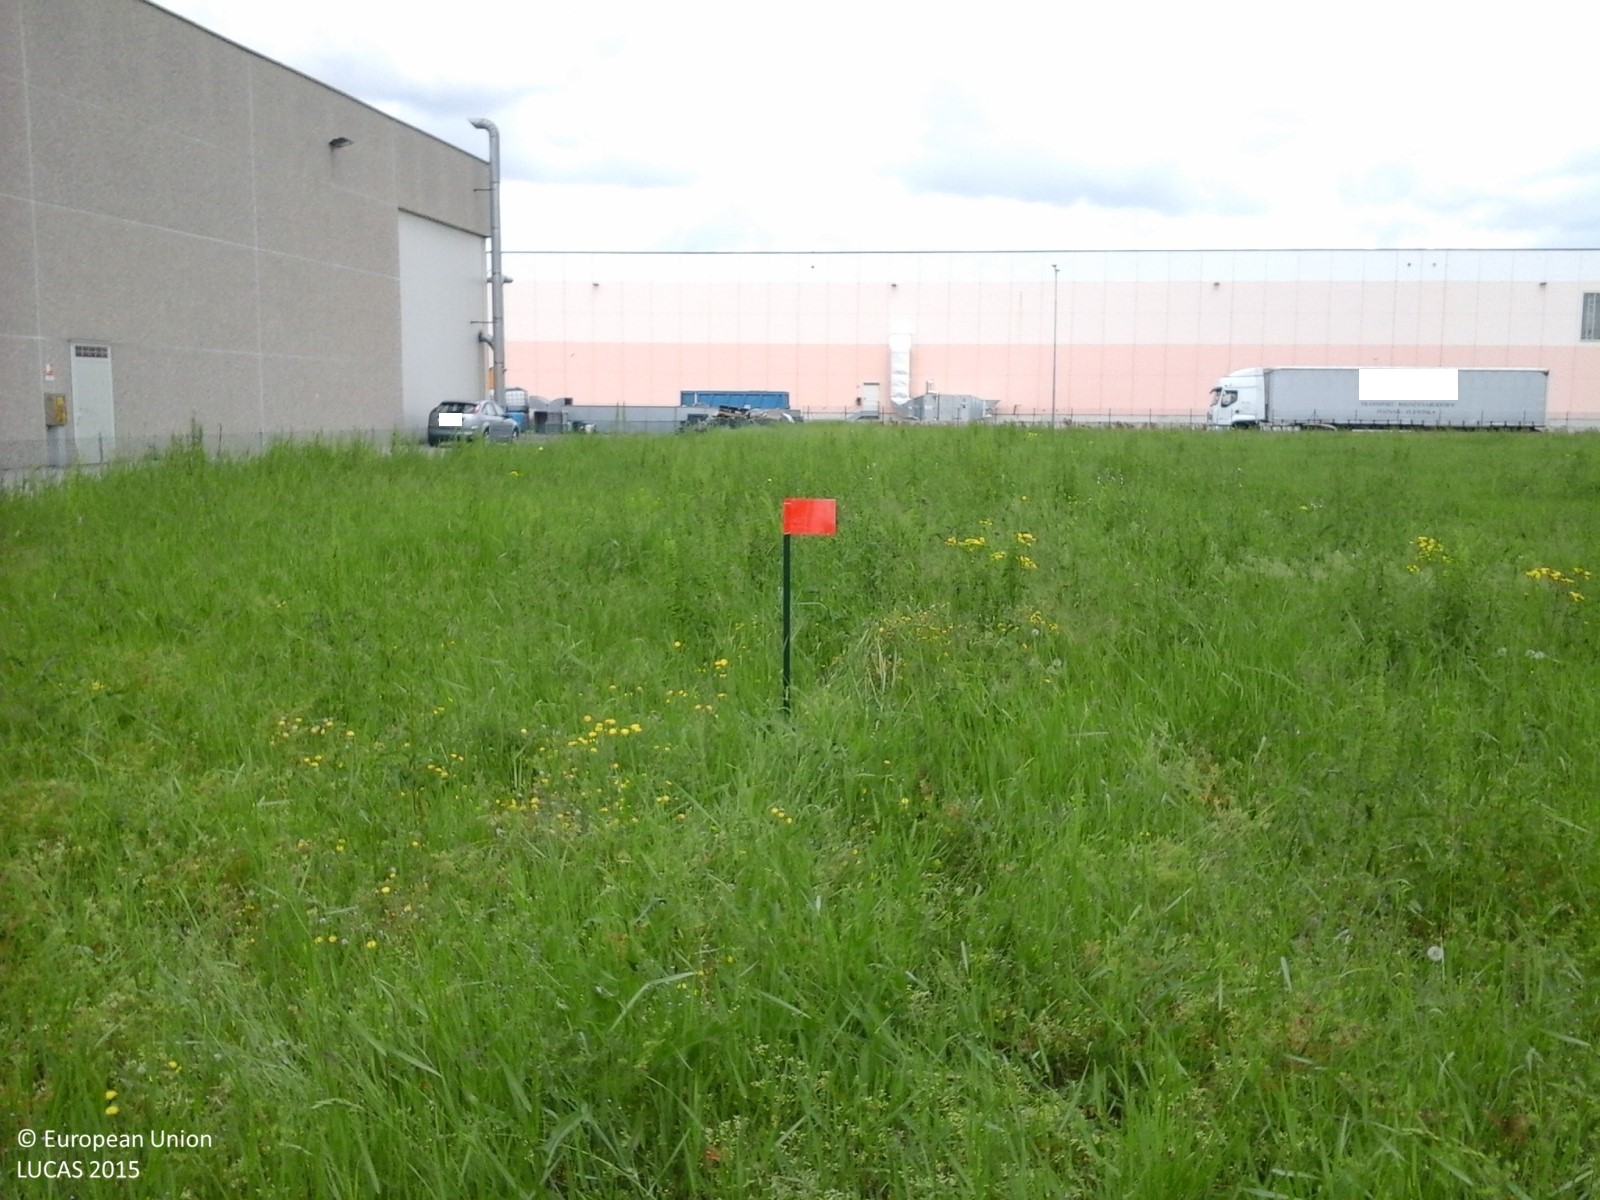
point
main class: Grassland
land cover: Grassland without tree/shrub cover
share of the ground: > 75 %
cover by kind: herbaceous plants 100 %
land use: Semi-natural and natural areas not in use
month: April
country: IT
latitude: 44.8701
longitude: 10.8463
